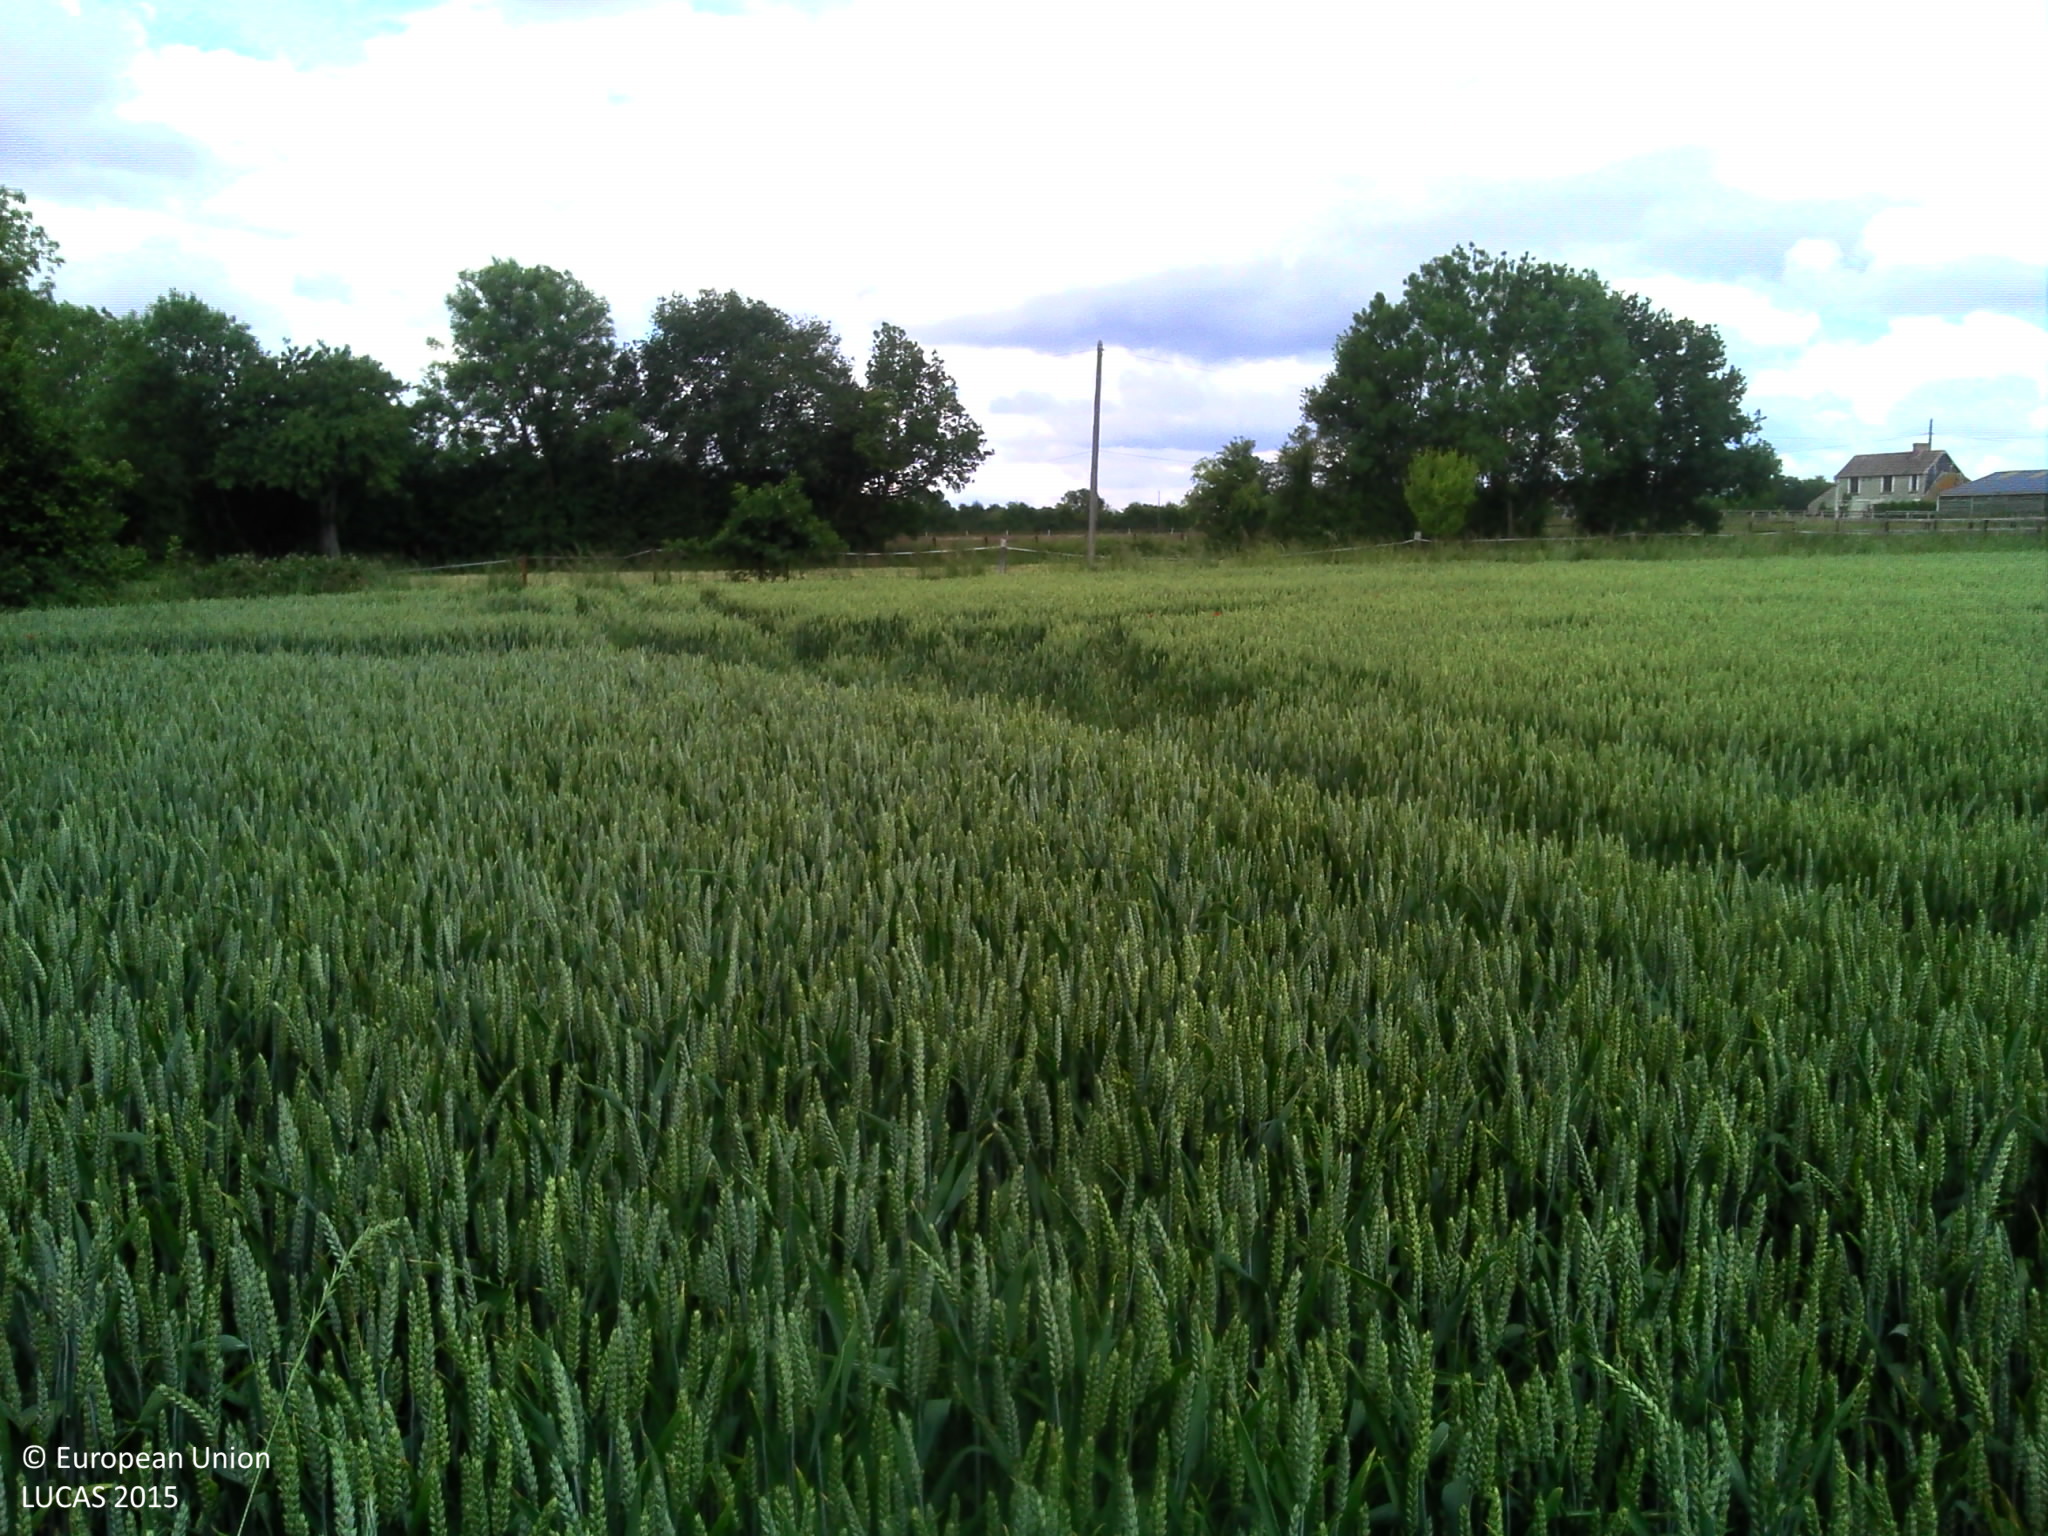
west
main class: Cropland
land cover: Common wheat
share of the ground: > 75 %
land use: Agriculture (excluding fallow land and kitchen gardens)
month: June
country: FR
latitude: 49.0212
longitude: 0.4423
